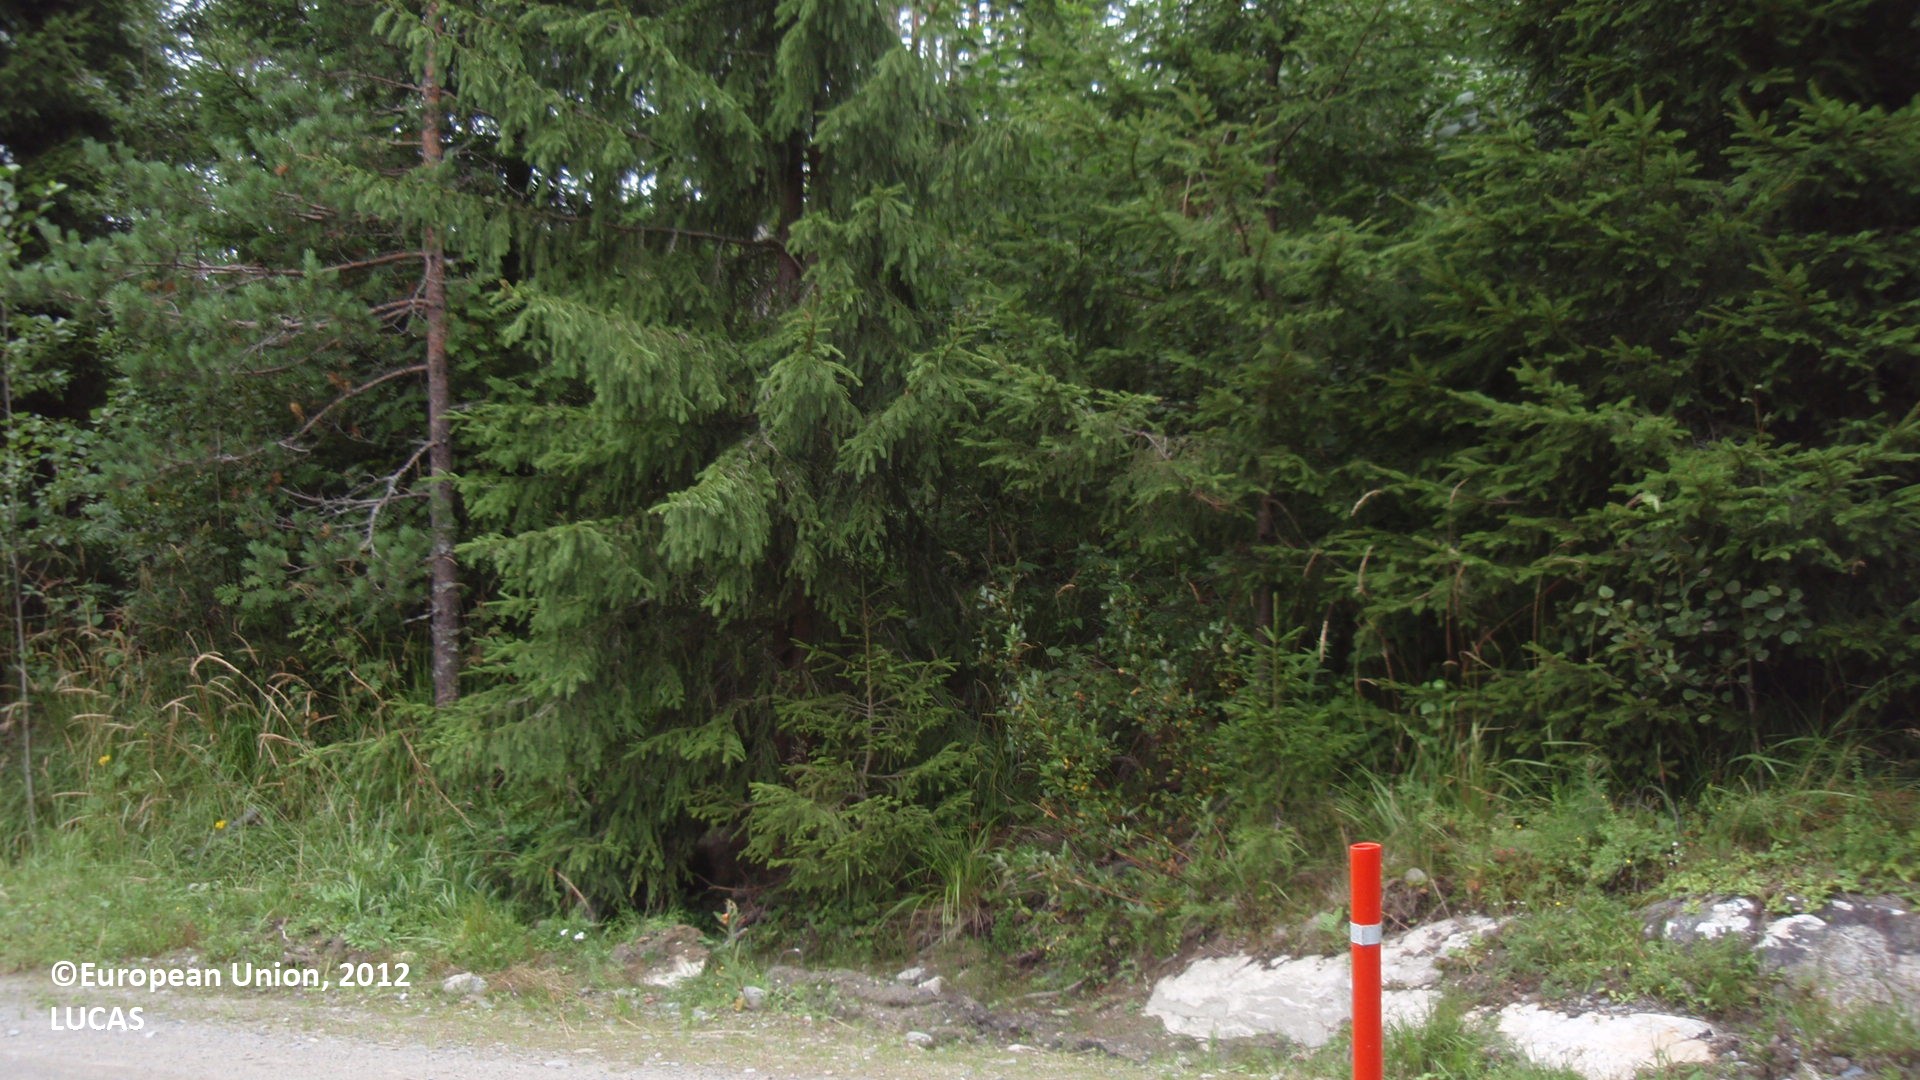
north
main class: Shrubland
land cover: Shrubland with sparse tree cover
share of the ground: > 75 %
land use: Abandoned areas
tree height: < 5 m
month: August
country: FI
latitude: 61.5852
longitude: 27.0998
